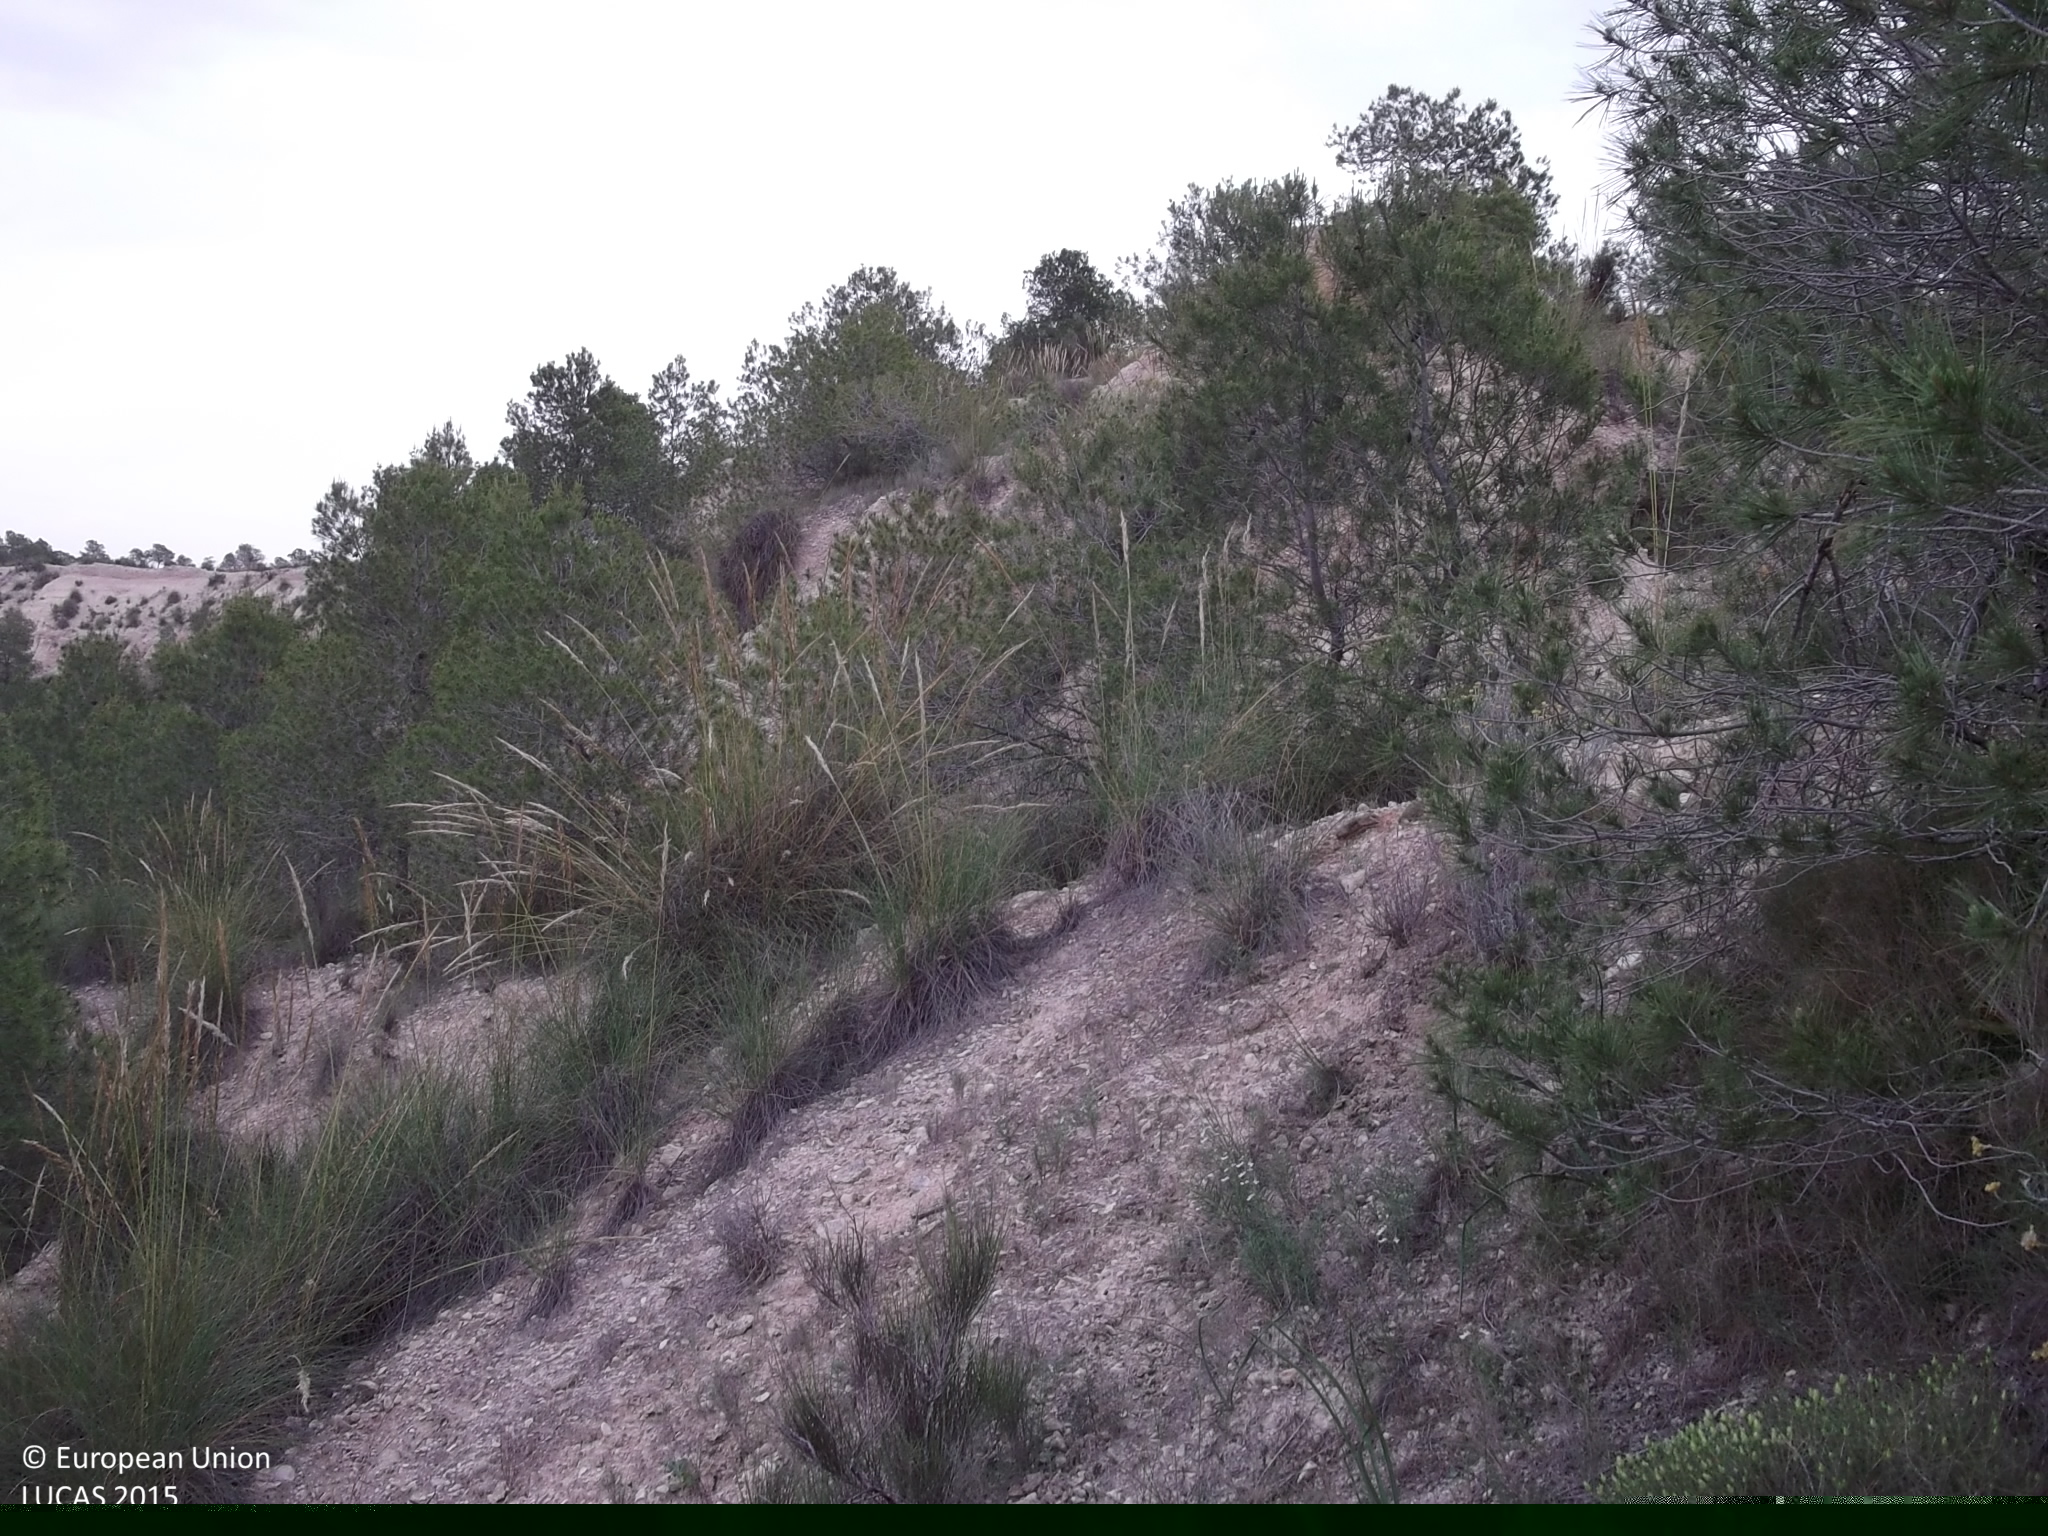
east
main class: Woodland
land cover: Pine dominated coniferous woodland
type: coniferous forest of the mediterranean region
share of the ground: 10 - 25 %
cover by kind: shrubs 40 %, consolidated bare surface 40 %, coniferous forest trees 20 %
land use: Semi-natural and natural areas not in use
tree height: < 5 m
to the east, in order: Pine dominated coniferous woodland; Tracks; Pine dominated coniferous woodland; Other bare soil; Shrubland without tree cover; Pine dominated coniferous woodland
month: May
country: ES
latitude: 38.2992
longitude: -1.4353
